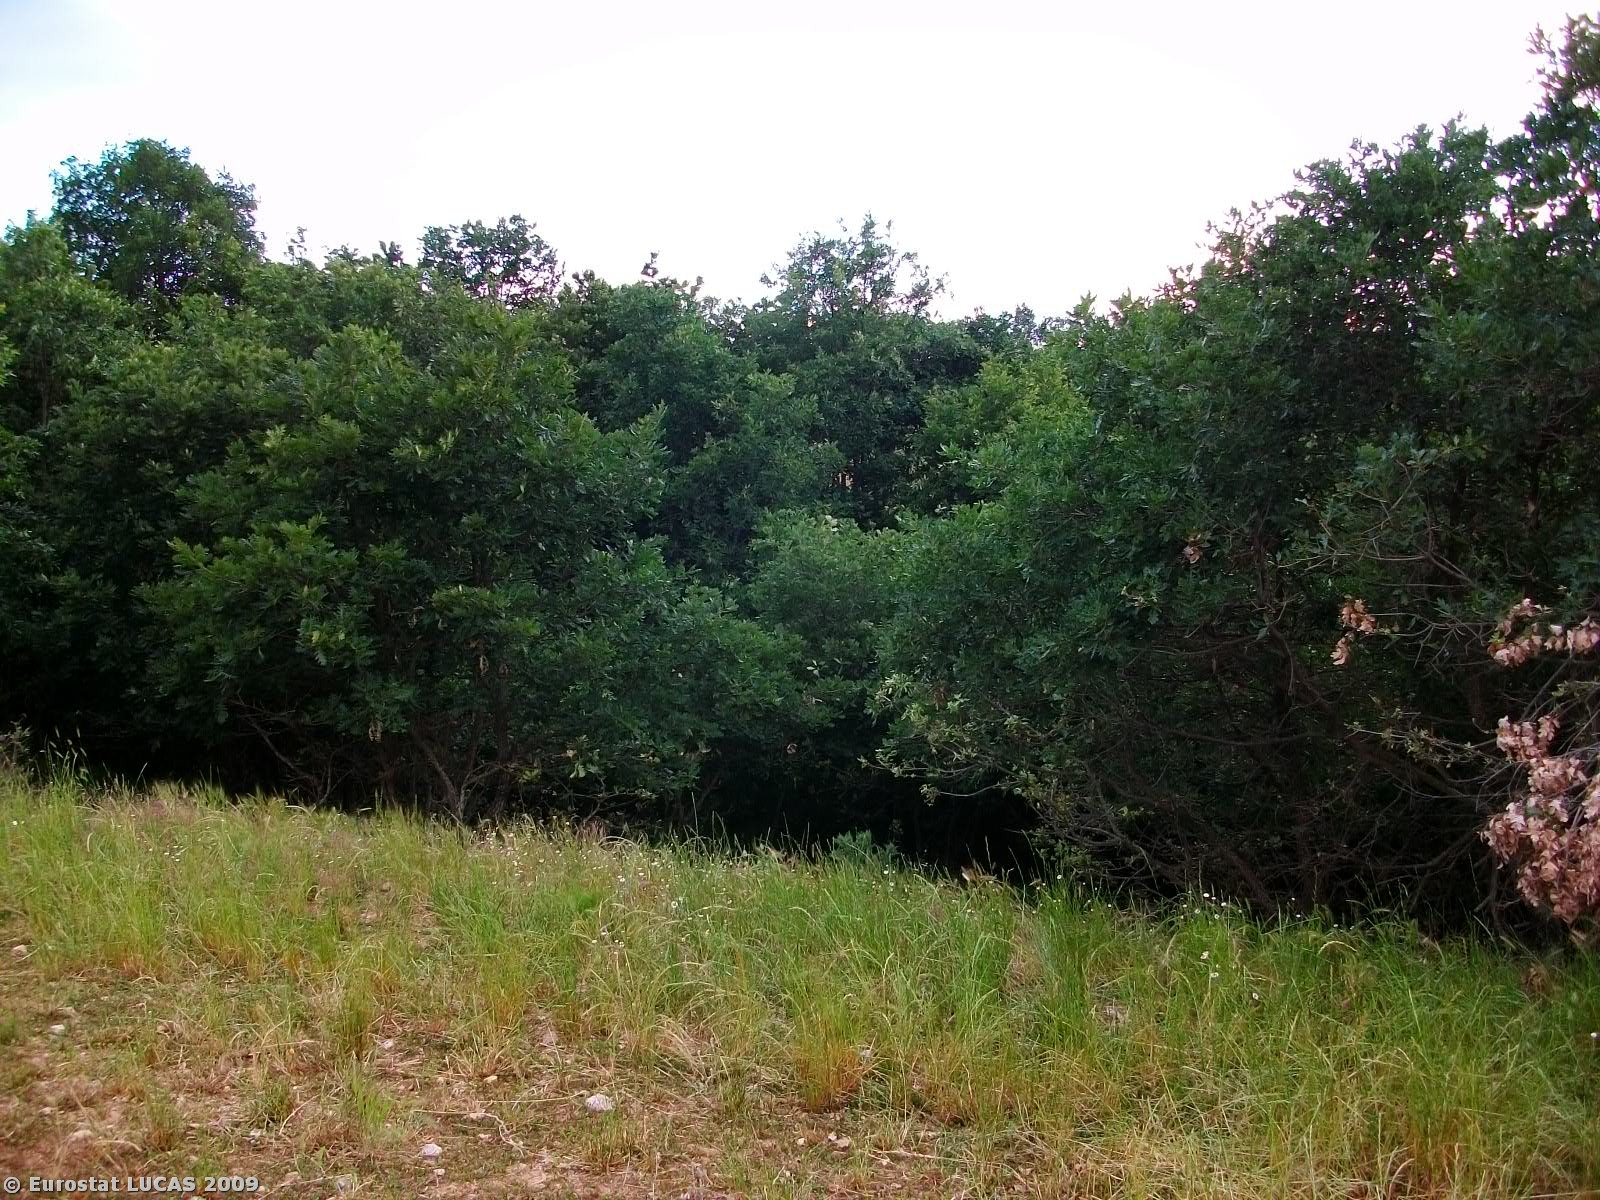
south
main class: Grassland
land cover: Spontaneously vegetated surfaces
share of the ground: > 75 %
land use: Fallow land
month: June
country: GR
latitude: 39.9038
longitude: 21.7660
